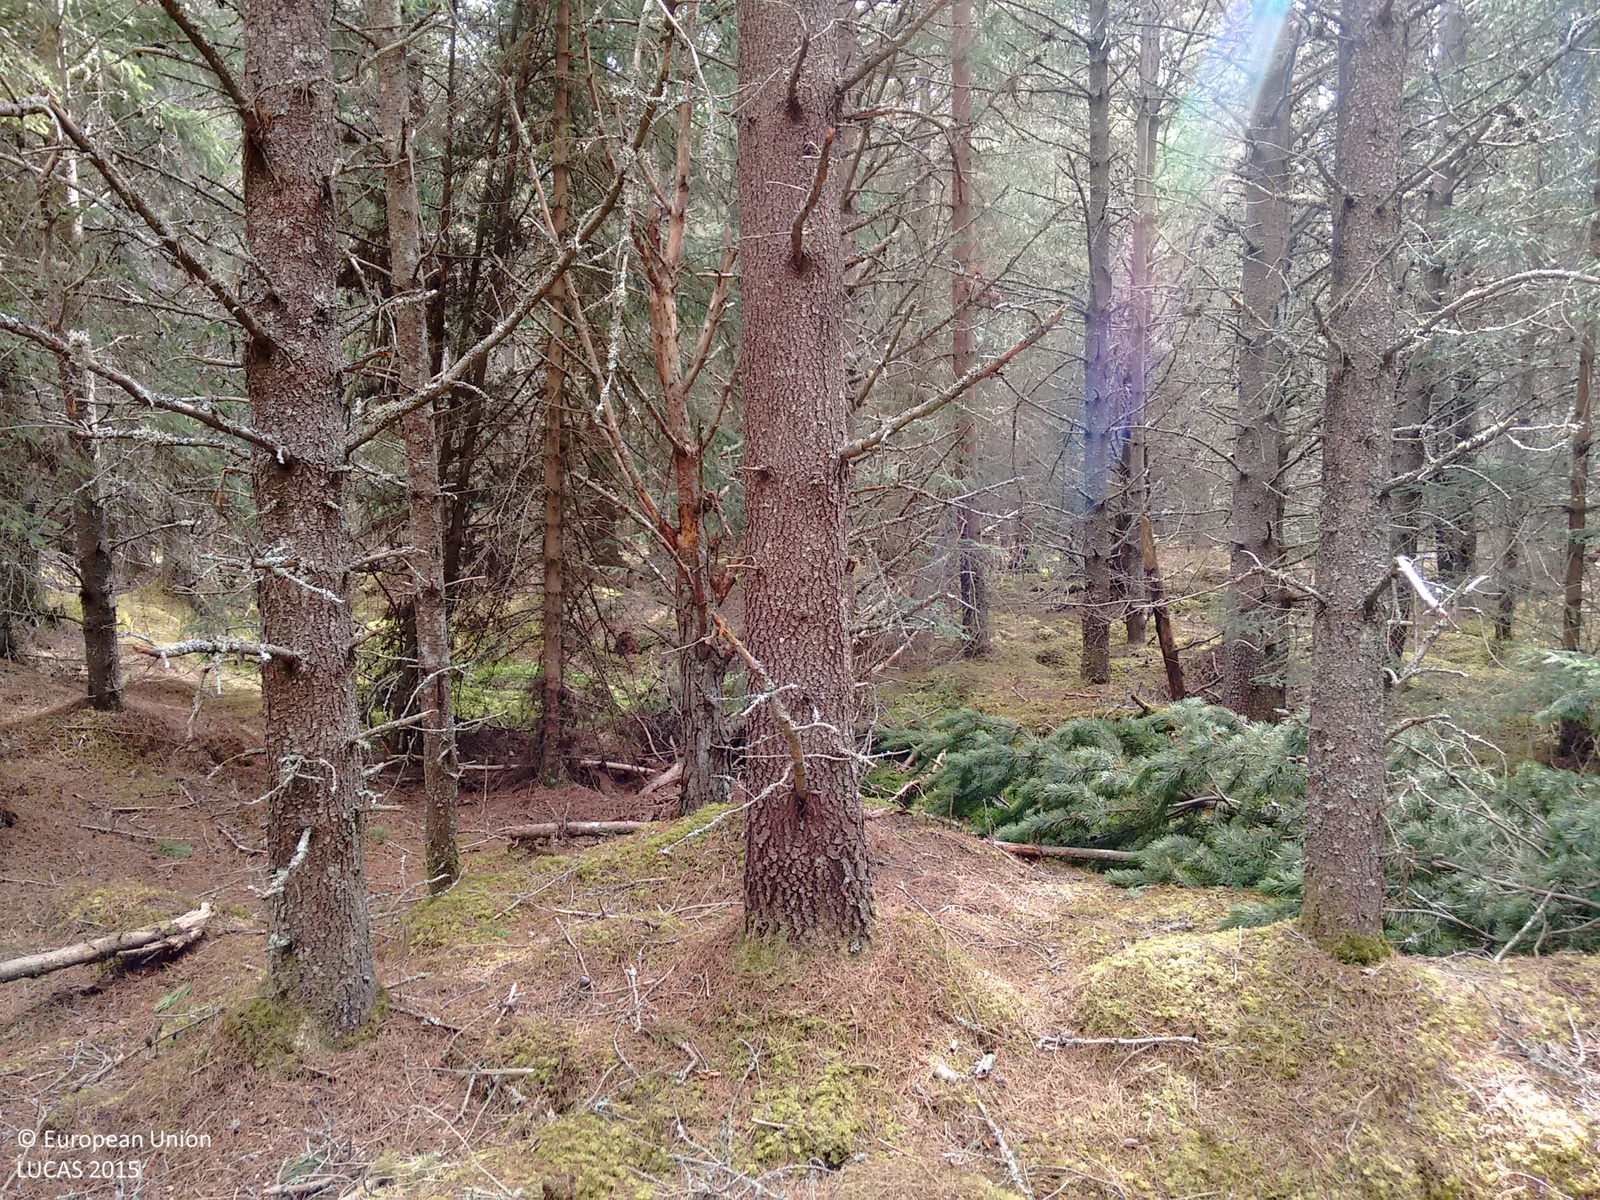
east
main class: Woodland
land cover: Spruce dominated coniferous woodland
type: exotic forest
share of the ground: > 75 %
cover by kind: coniferous forest trees 85 %, lichens and mosses 15 %
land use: Forestry
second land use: Amenities, museums, leisure
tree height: > 5 m
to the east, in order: Spruce dominated coniferous woodland; Lichens and moss; Spruce dominated coniferous woodland; Peatbogs
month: June
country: GB
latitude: 57.1816
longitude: -3.7247
